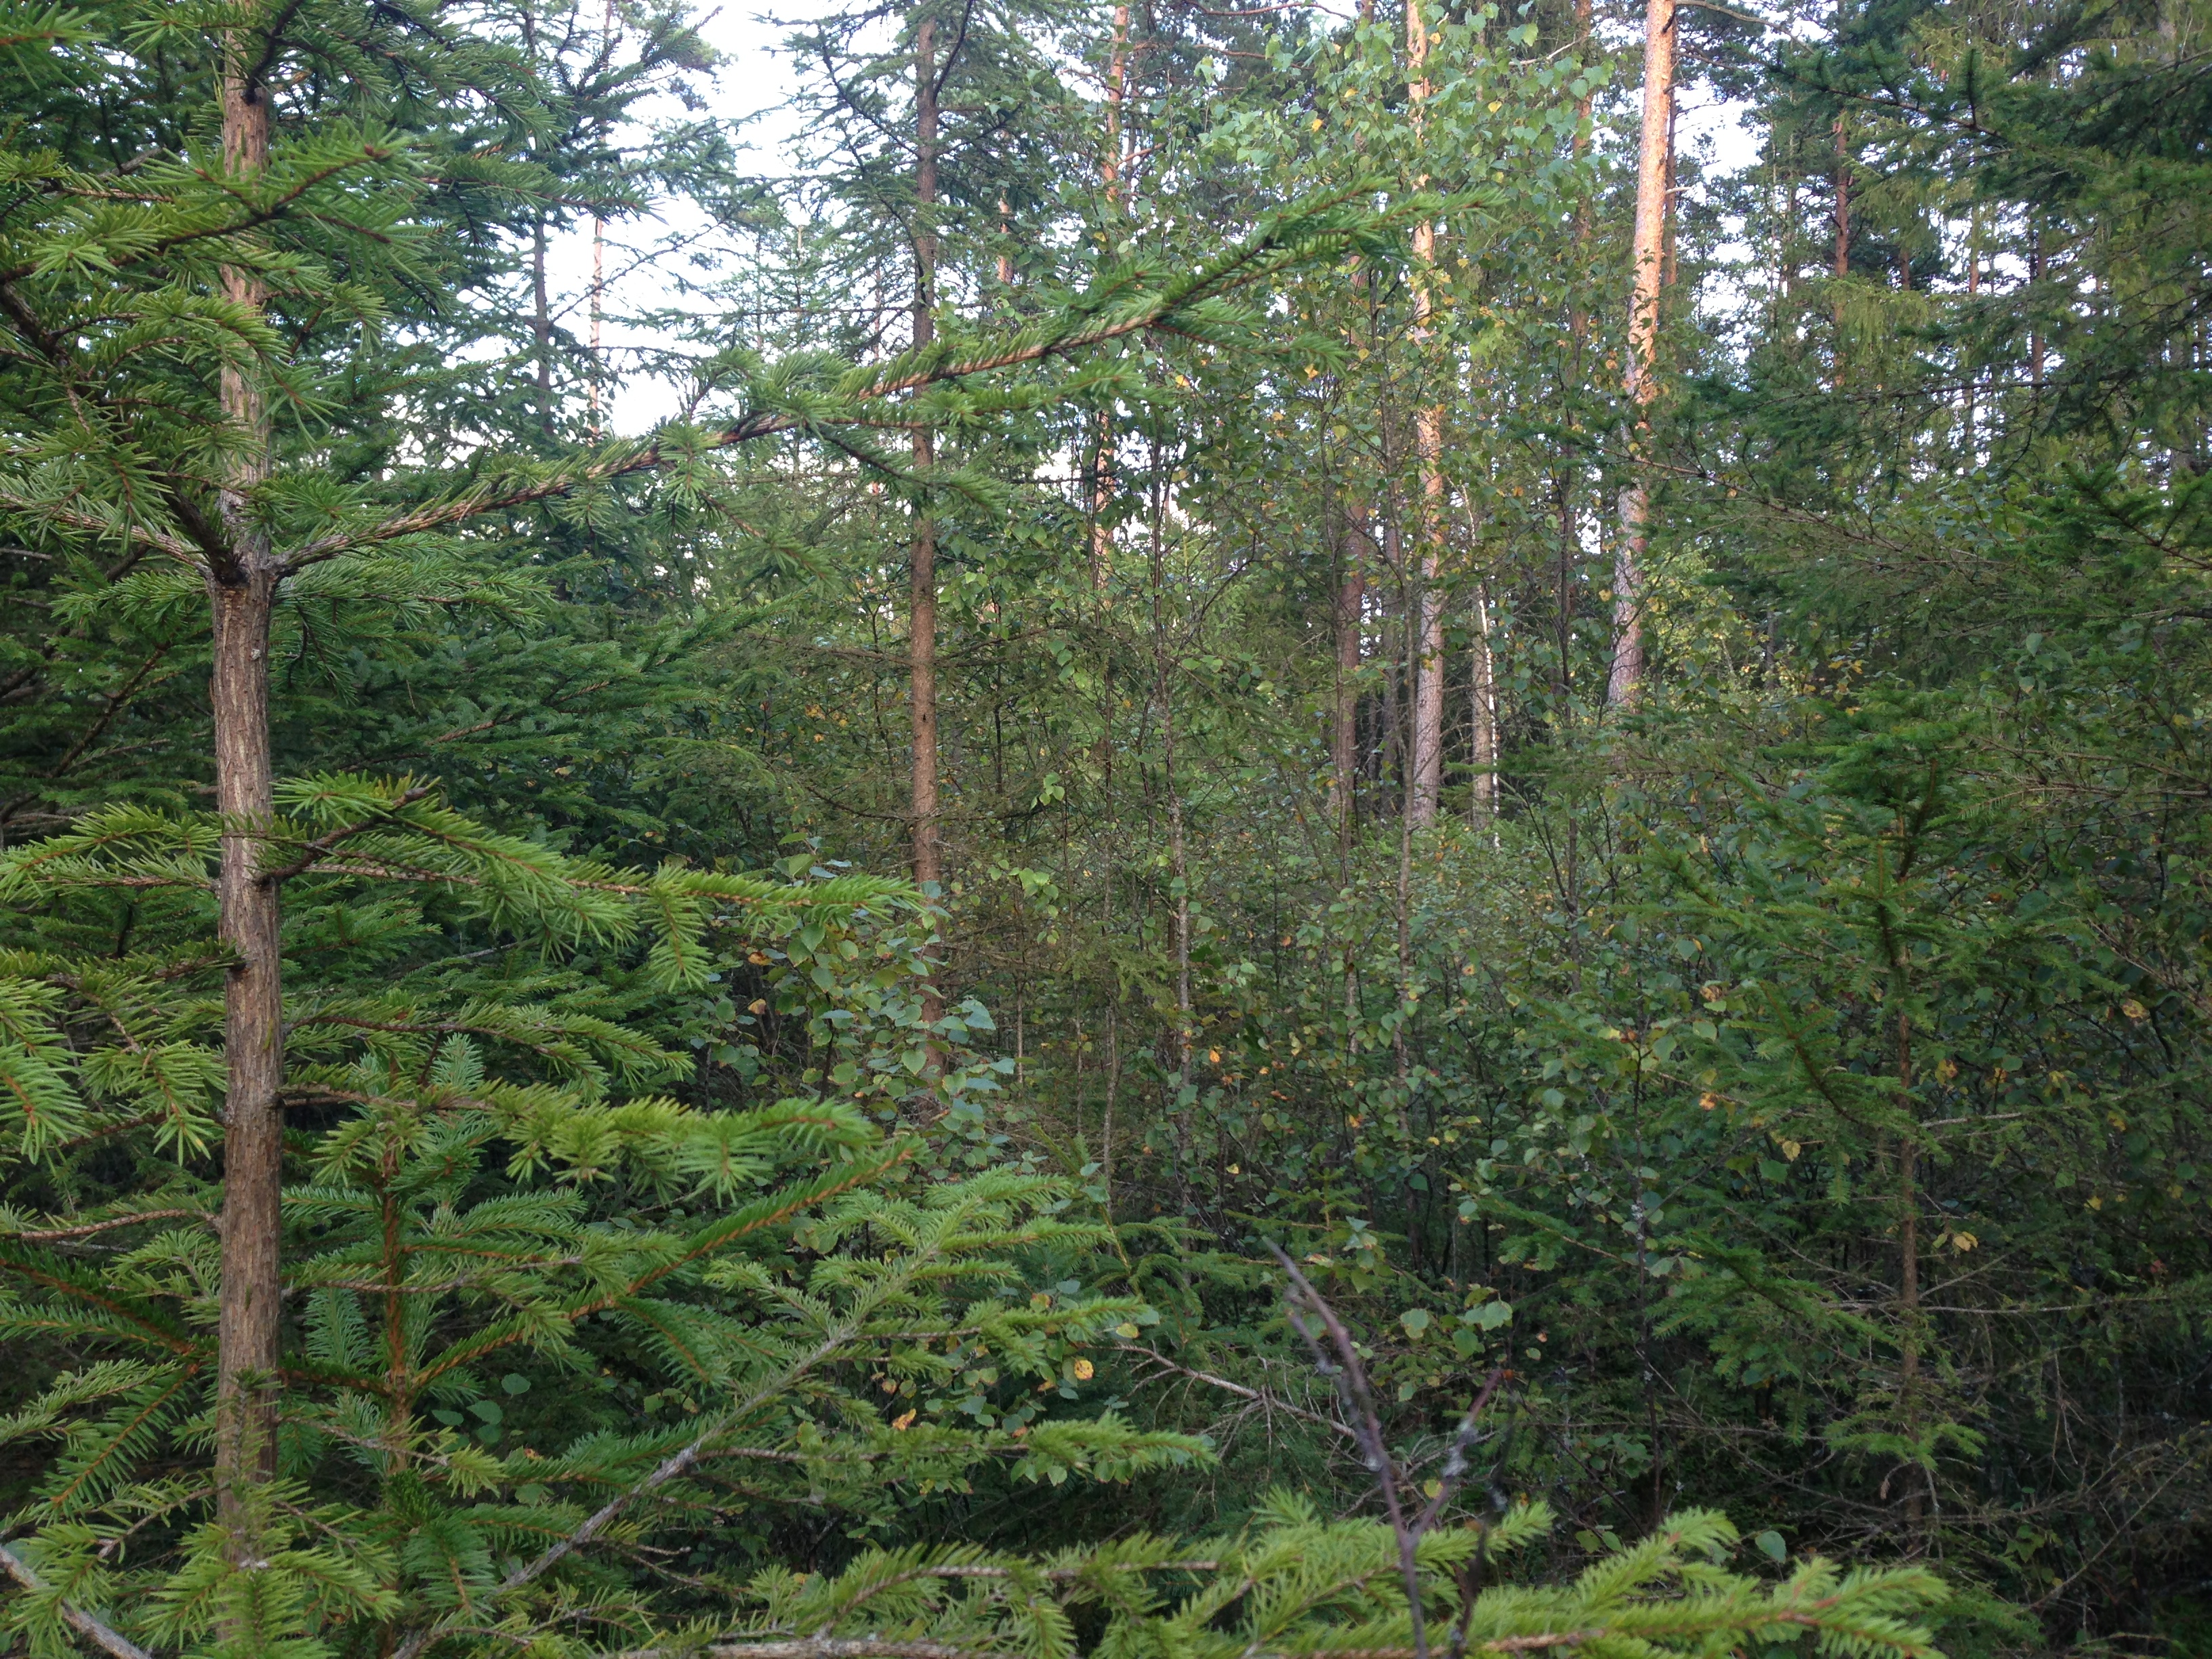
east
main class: Woodland
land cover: Spruce dominated mixed woodland
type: boreal forest
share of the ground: > 75 %
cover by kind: coniferous forest trees 60 %, broadleaved forest trees 20 %, shrubs 20 %
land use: Forestry
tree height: > 5 m
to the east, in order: Spruce dominated mixed woodland; Other coniferous woodland; Spruce dominated coniferous woodland; Shrubland with sparse tree cover; Spruce dominated mixed woodland; Tracks; Spruce dominated mixed woodland; Paved roads, cycling and walking lanes; Spruce dominated coniferous woodland
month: September
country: SE
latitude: 57.1207
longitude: 13.1508
